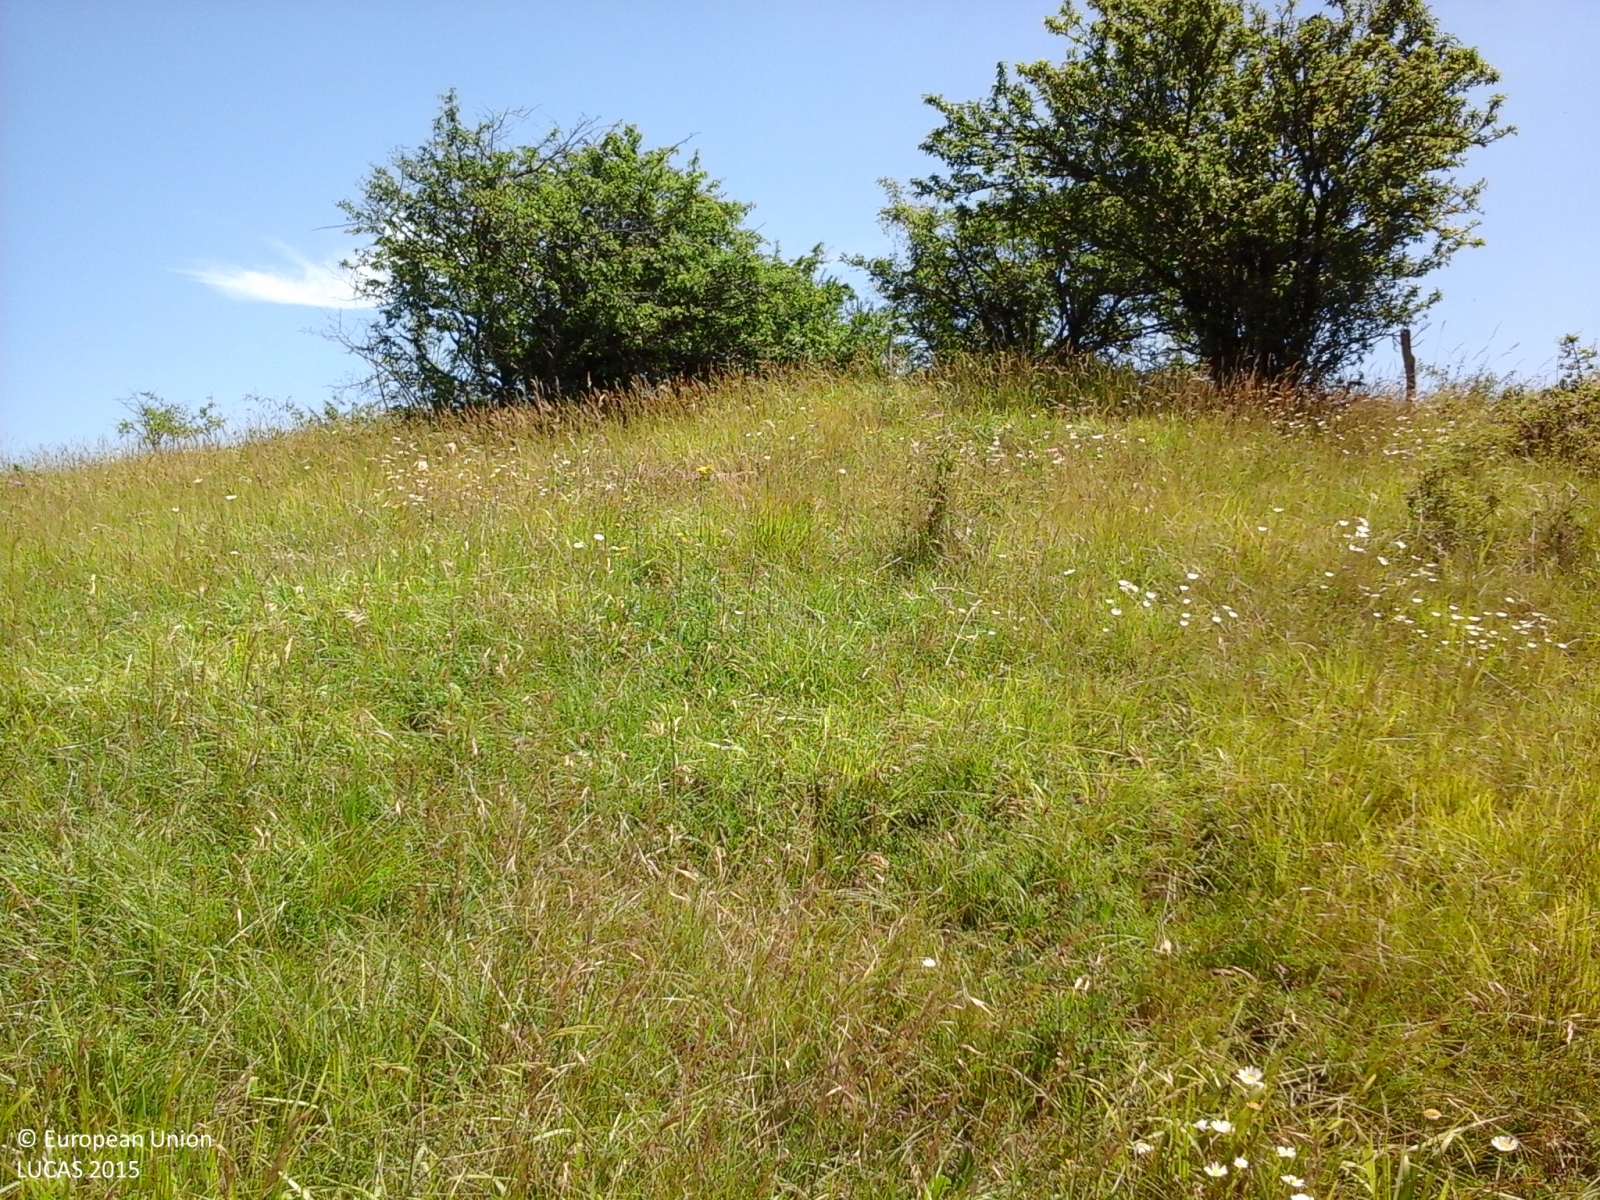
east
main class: Shrubland
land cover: Shrubland with sparse tree cover
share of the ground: > 75 %
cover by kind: shrubs 75 %, herbaceous plants 20 %, broadleaved forest trees 5 %
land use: Agriculture (excluding fallow land and kitchen gardens)
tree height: < 5 m
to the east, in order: Shrubland with sparse tree cover; Shrubland without tree cover; Paved roads, cycling and walking lanes; Grass margins; Artificial constructions; Shrubland with sparse tree cover; Electric lines; Shrubland without tree cover
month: June
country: IT
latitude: 44.3225
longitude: 11.4387
